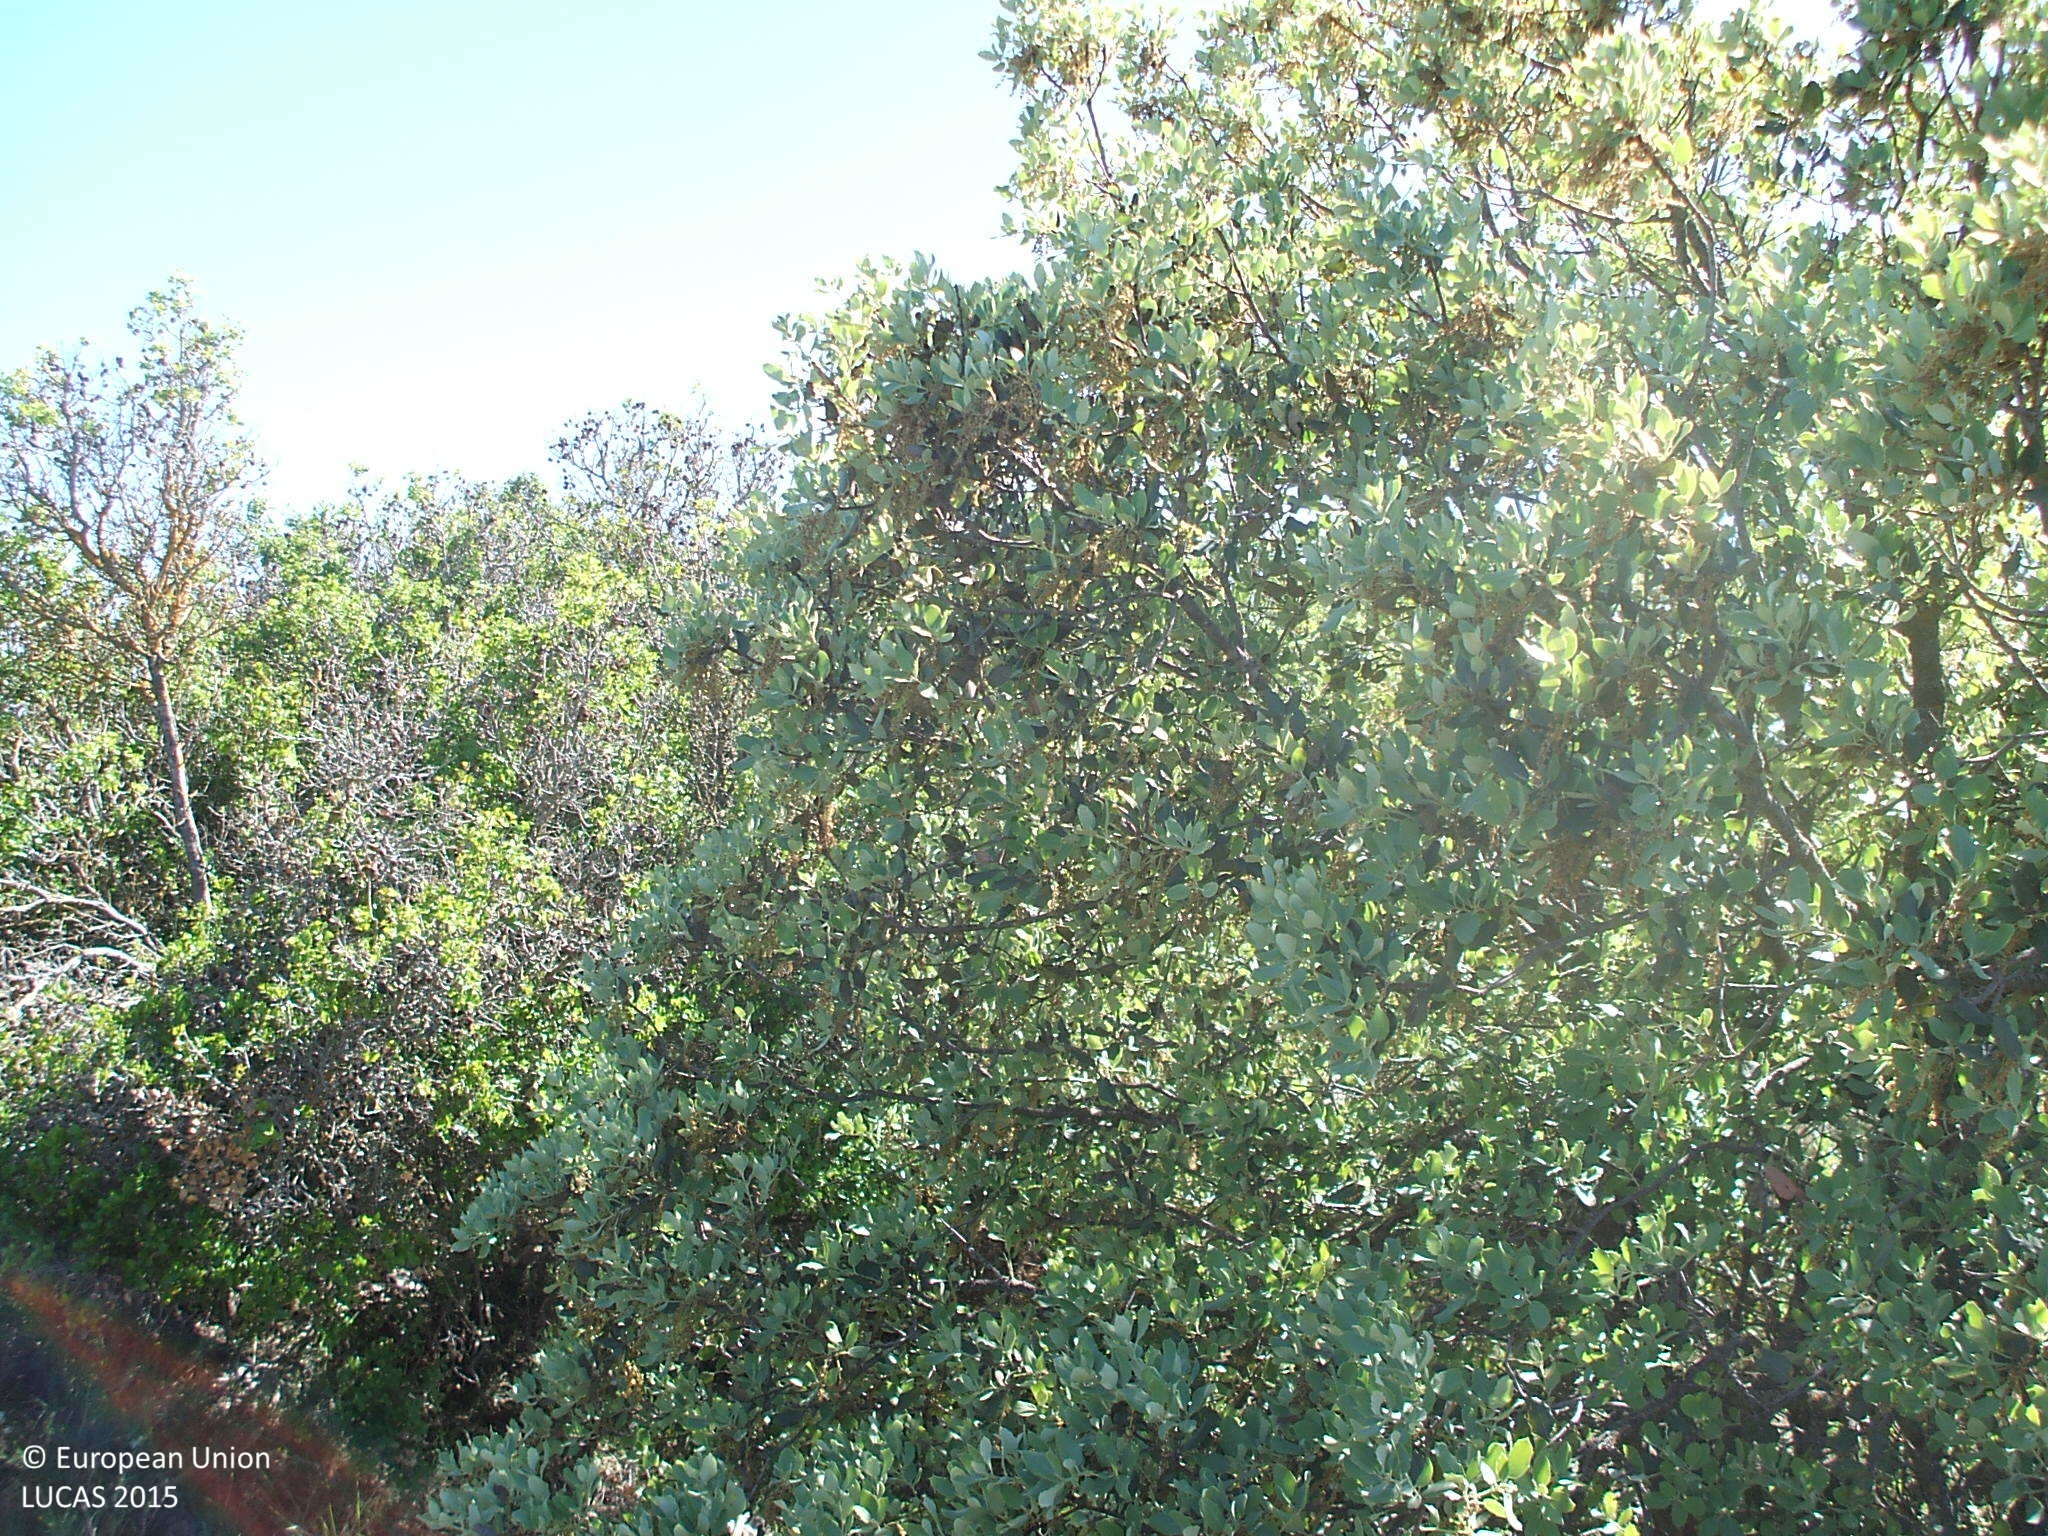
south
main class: Woodland
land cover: Other mixed woodland
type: coniferous forest of the mediterranean region
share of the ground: 25 - 50 %
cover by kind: herbaceous plants 40 %, unconsolidated bare surface 25 %, coniferous forest trees 15 %, broadleaved forest trees 15 %, shrubs 5 %
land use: Semi-natural and natural areas not in use
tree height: < 5 m
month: May
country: ES
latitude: 40.0445
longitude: -0.7061
